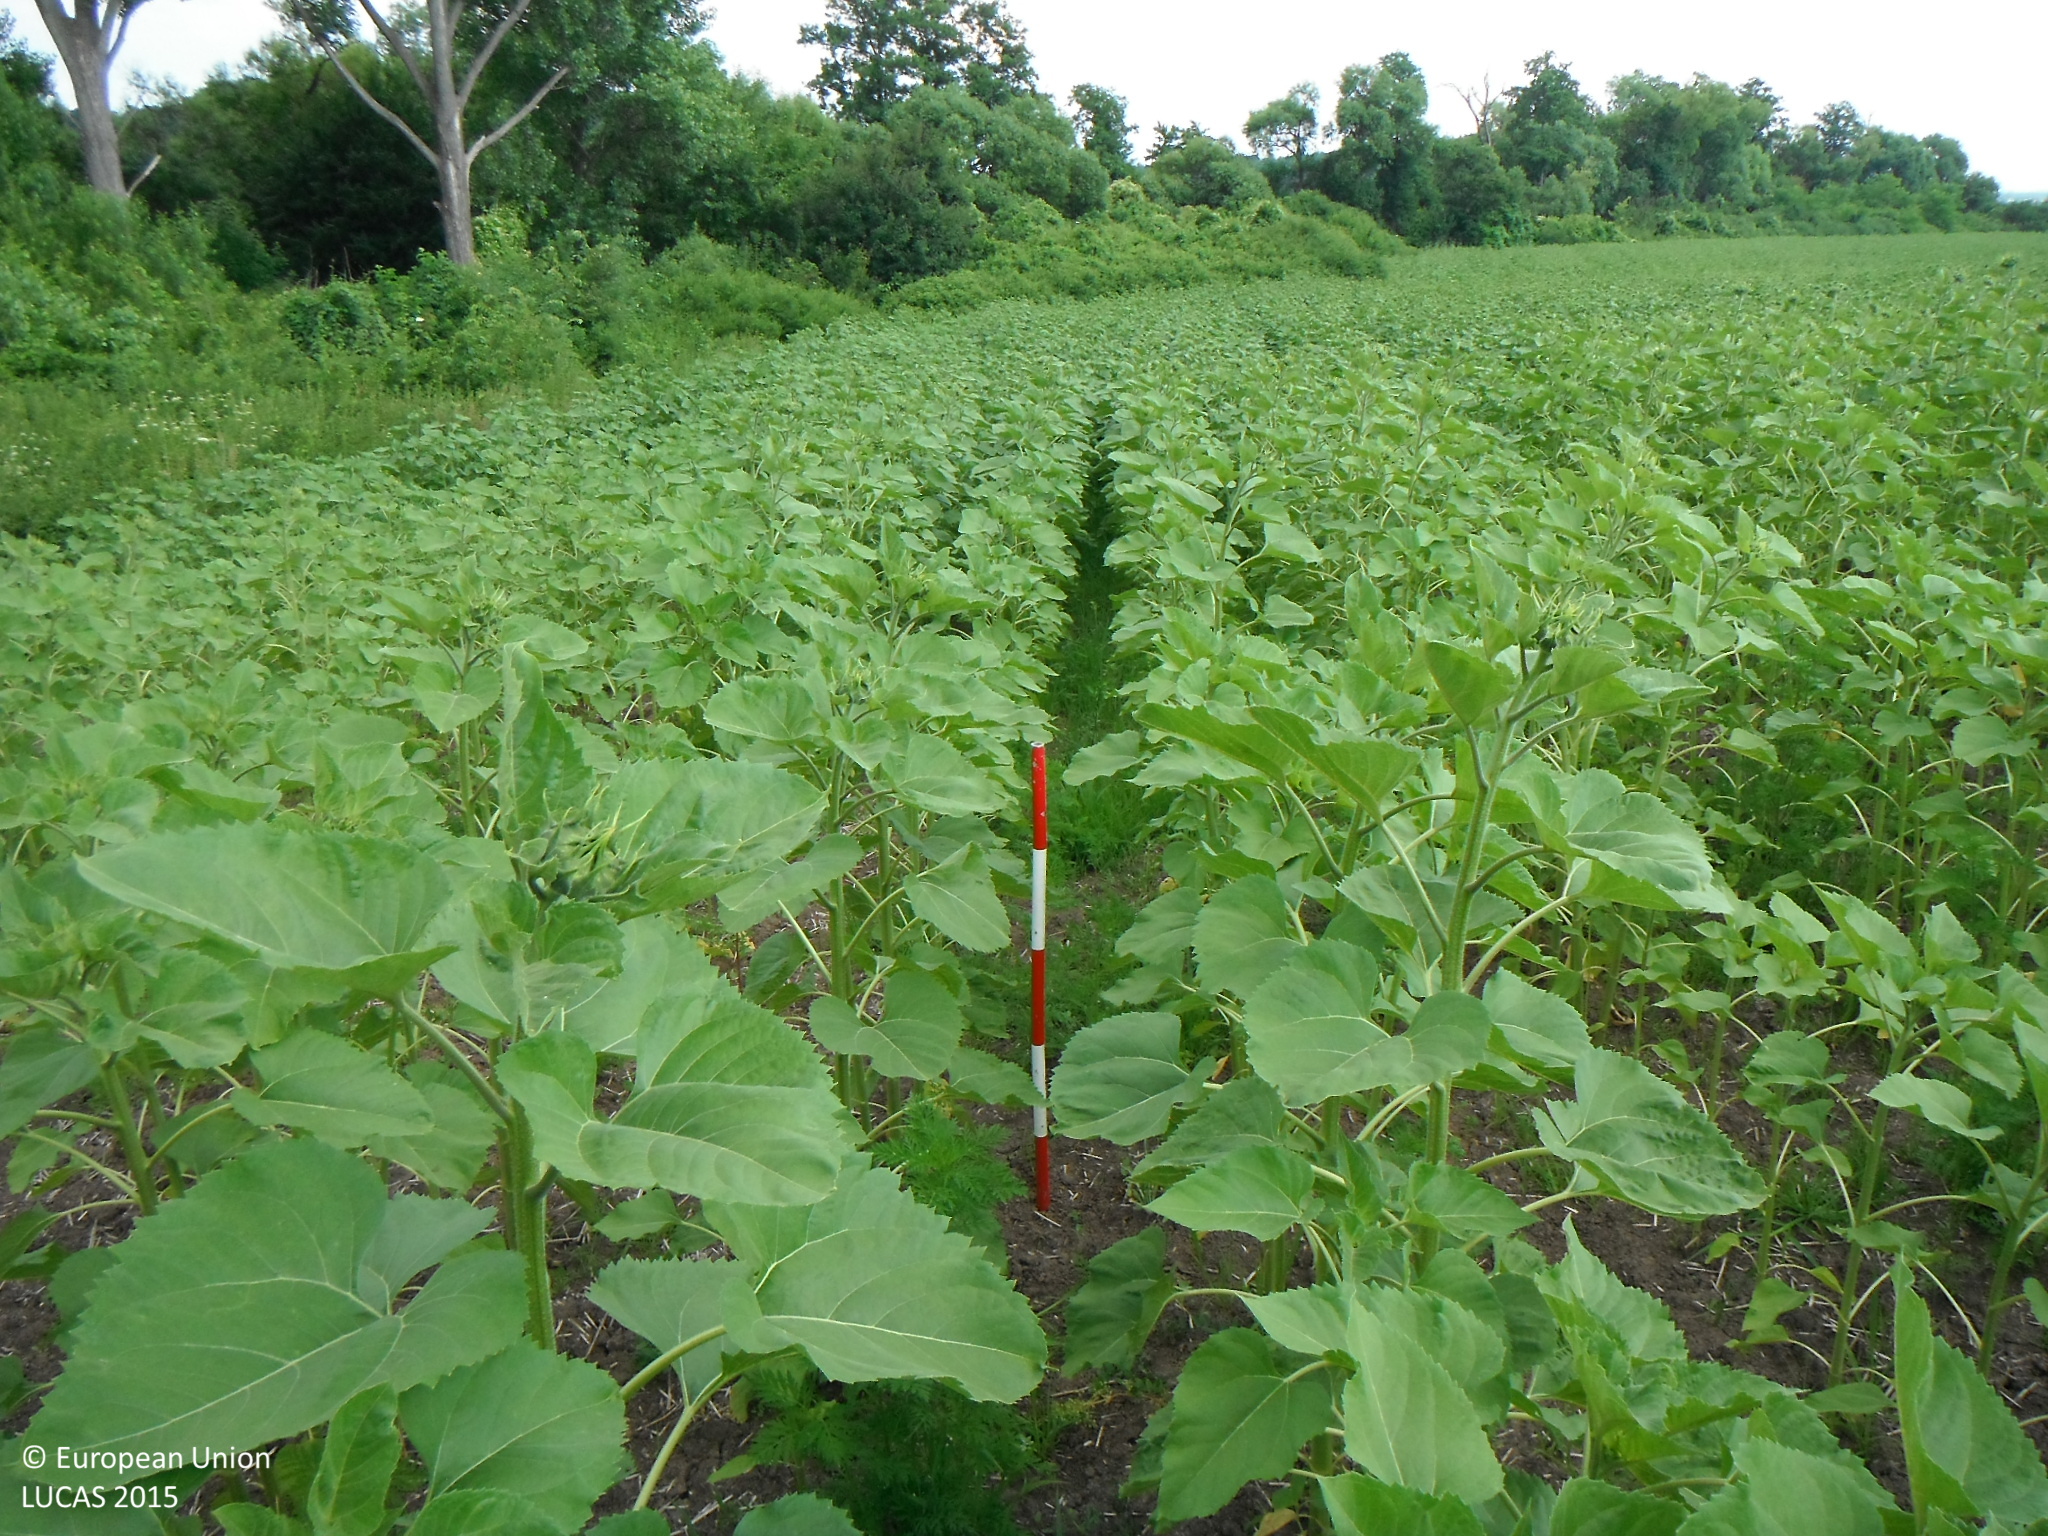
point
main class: Cropland
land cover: Sunflower
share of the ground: > 75 %
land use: Agriculture (excluding fallow land and kitchen gardens)
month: July
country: SK
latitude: 48.1035
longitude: 19.2746
